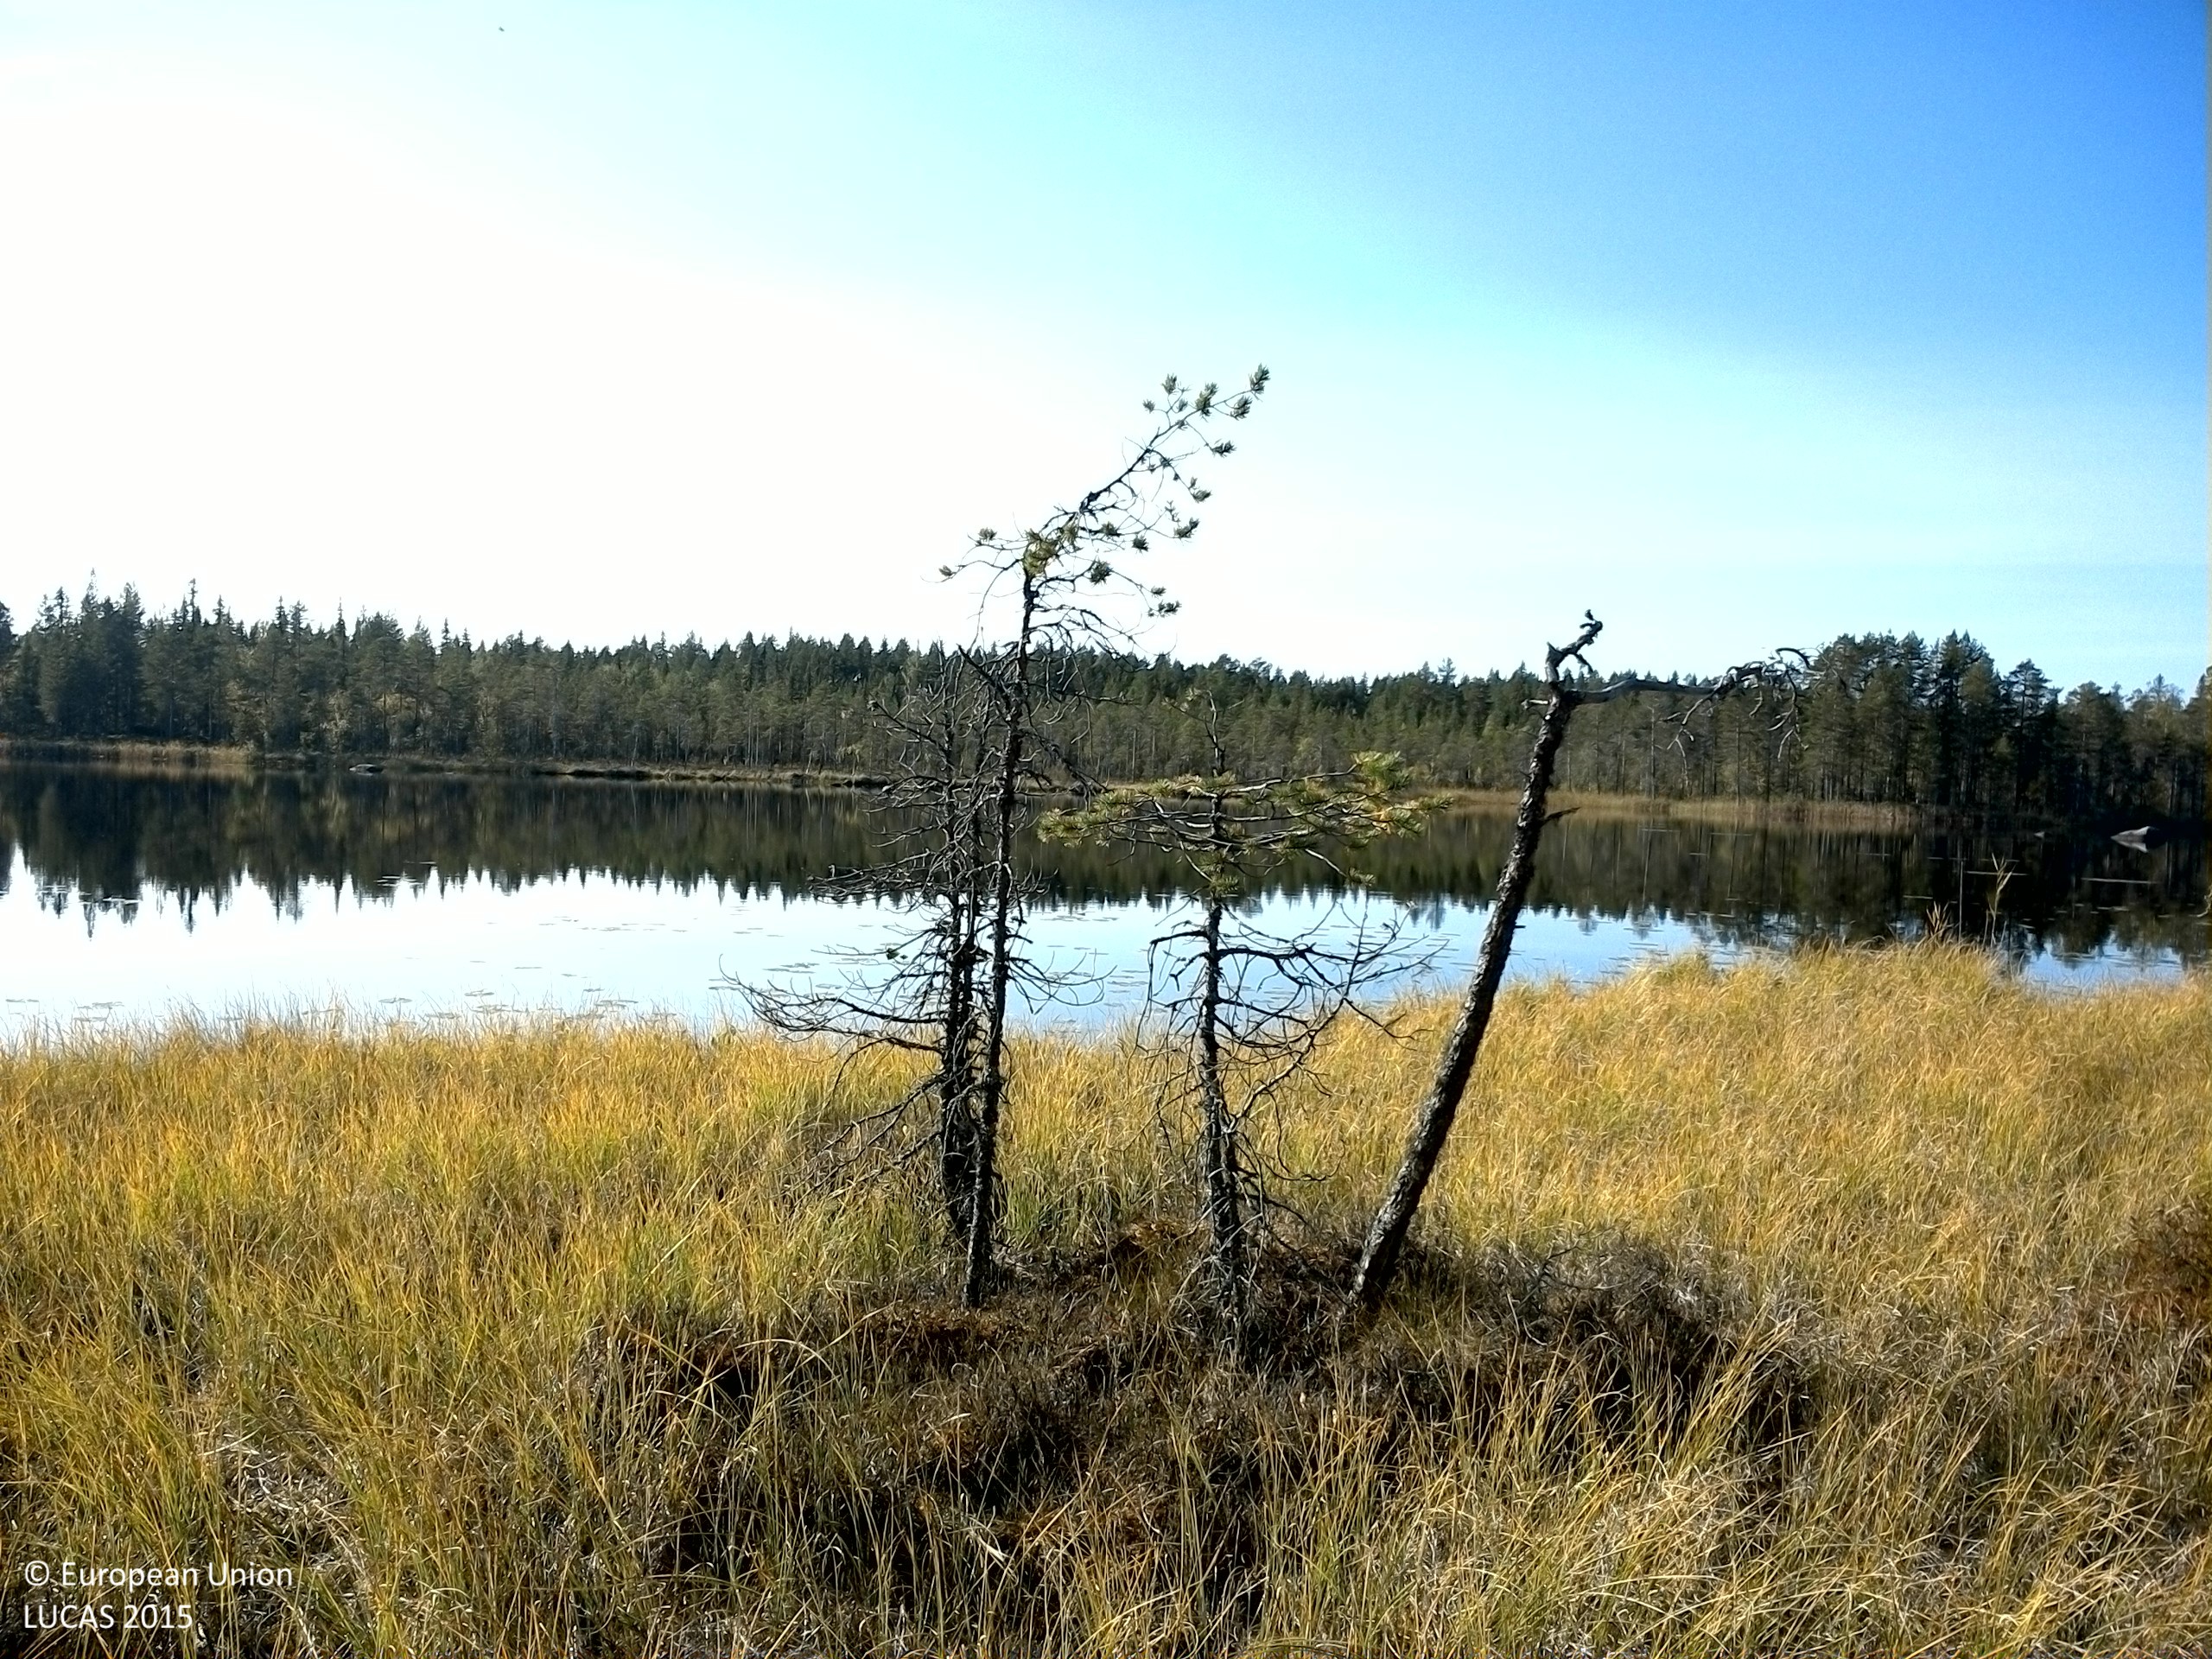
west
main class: Woodland
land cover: Pine dominated coniferous woodland
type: mire and swamp forests
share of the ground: 10 - 25 %
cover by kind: shrubs 35 %, herbaceous plants 35 %, coniferous forest trees 15 %, lichens and mosses 15 %
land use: Semi-natural and natural areas not in use
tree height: < 5 m
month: September
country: SE
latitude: 63.9592
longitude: 16.4431
